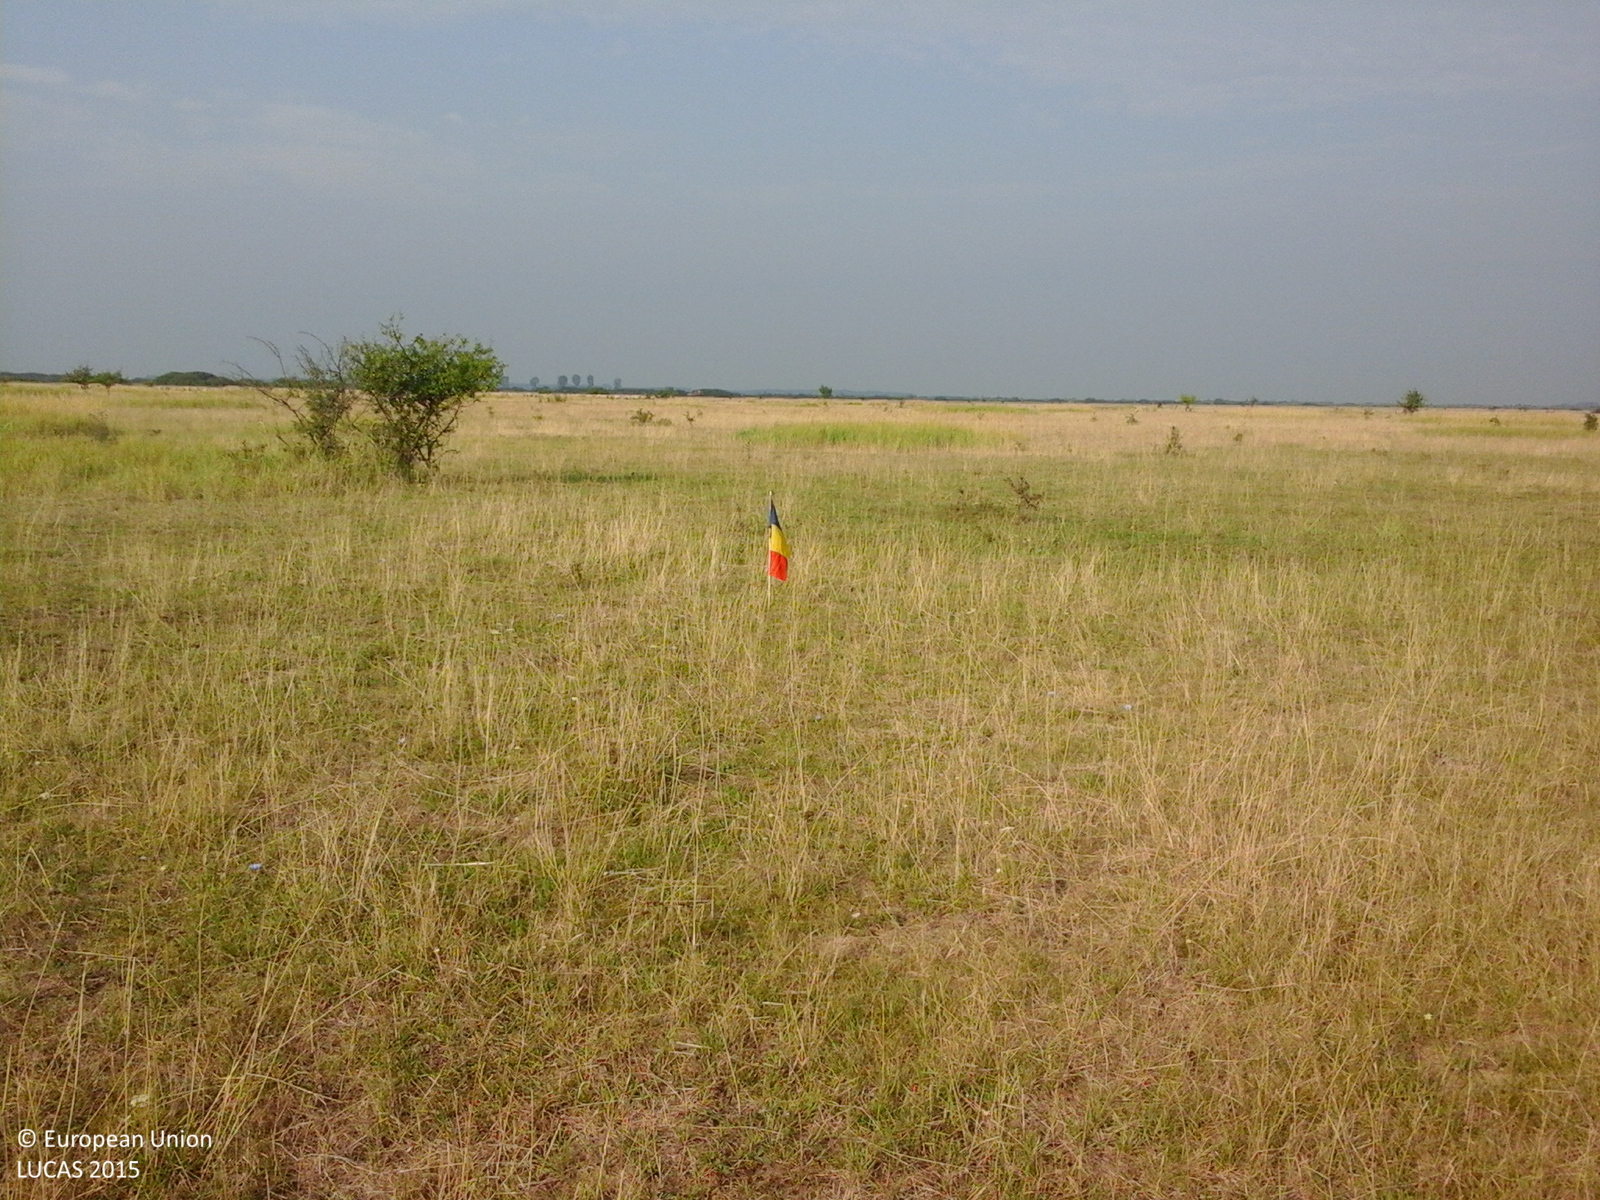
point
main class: Grassland
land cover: Grassland with sparse tree/shrub cover
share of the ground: > 75 %
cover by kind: herbaceous plants 85 %, shrubs 10 %, broadleaved forest trees 5 %
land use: Fallow land
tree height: < 5 m
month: August
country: RO
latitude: 46.5123
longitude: 21.6523
